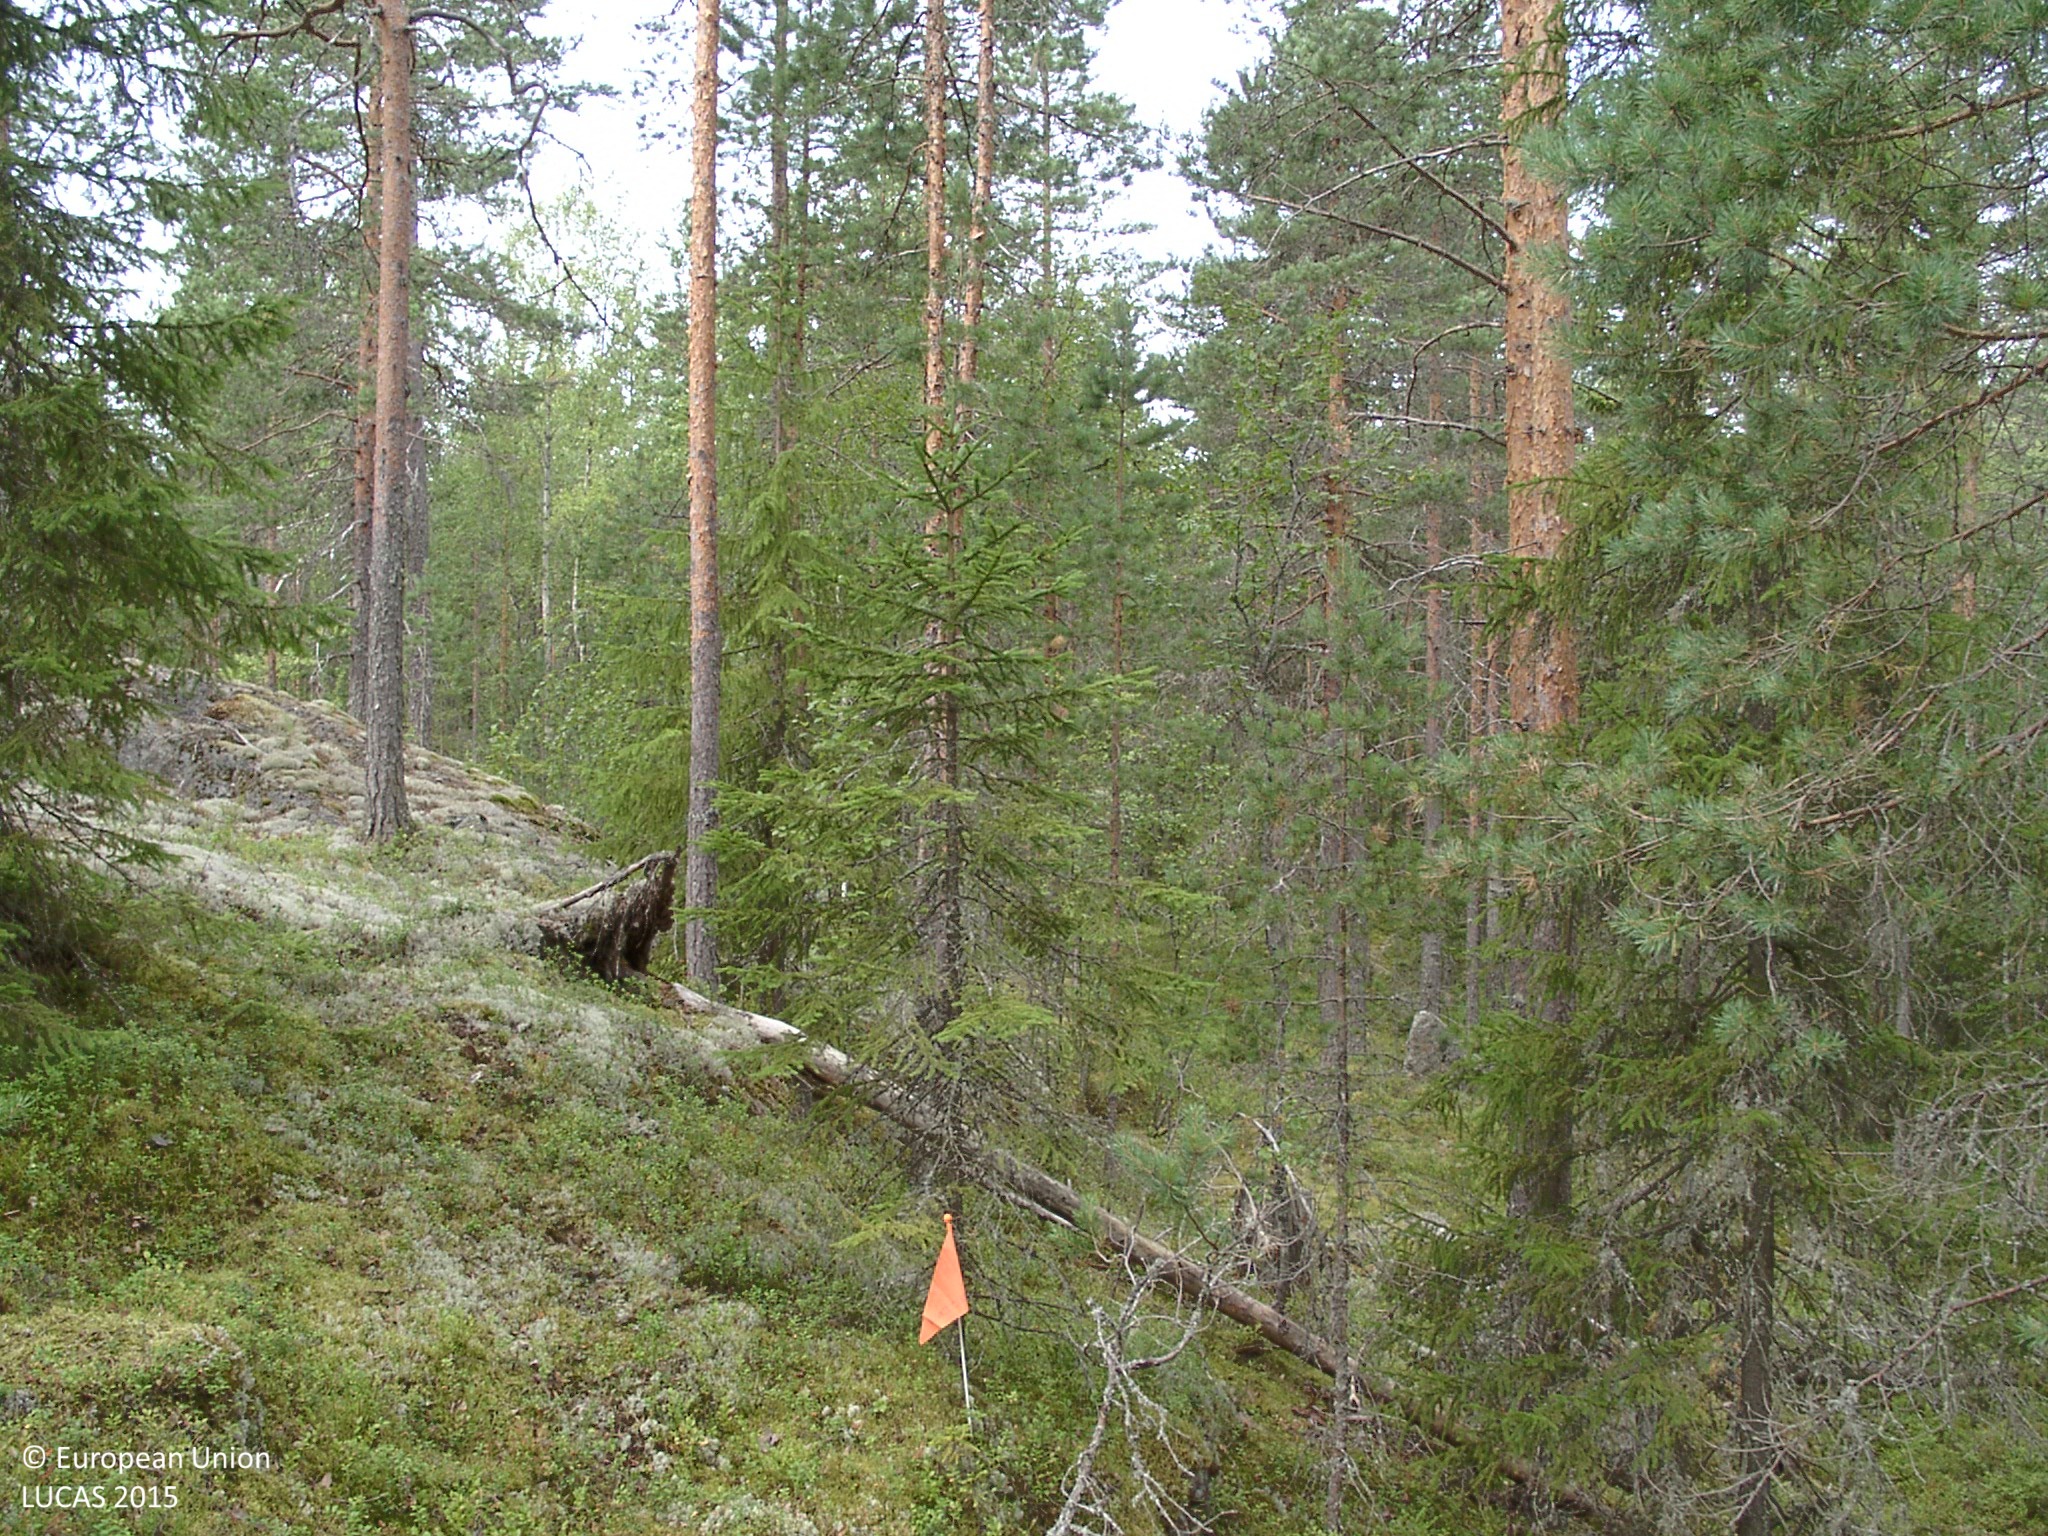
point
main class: Woodland
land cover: Other mixed woodland
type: boreal forest
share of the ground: 50 - 75 %
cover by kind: coniferous forest trees 40 %, lichens and mosses 25 %, shrubs 20 %, broadleaved forest trees 15 %
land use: Forestry
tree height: > 5 m
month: August
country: FI
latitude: 61.8604
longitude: 25.2996
